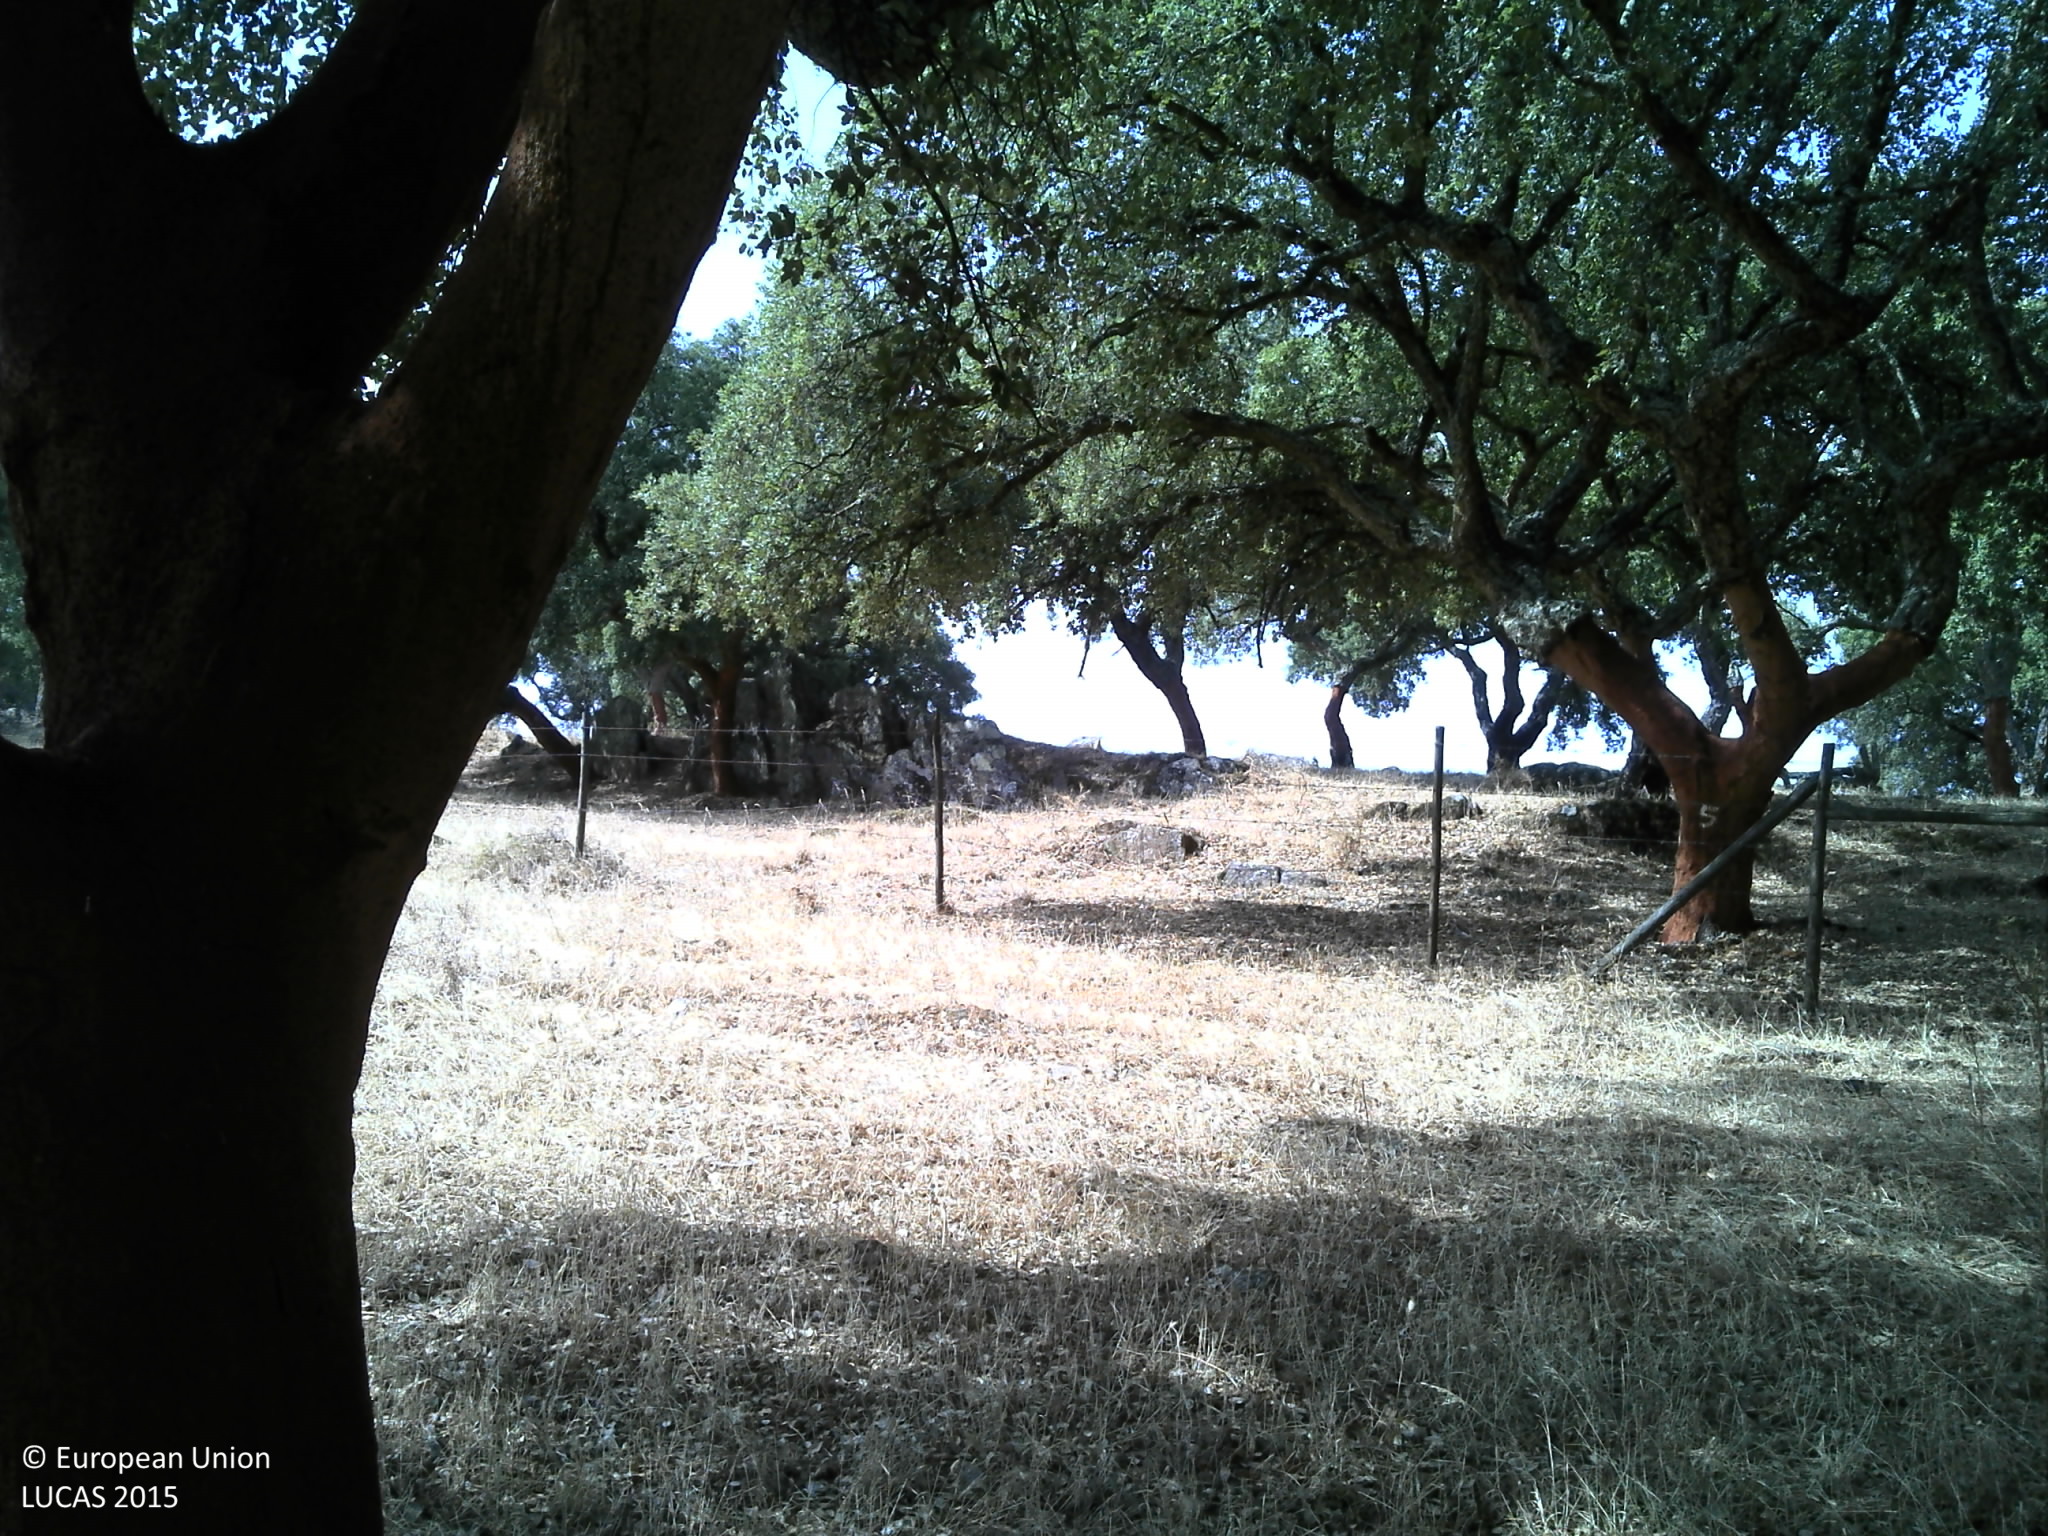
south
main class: Woodland
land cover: Broadleaved woodland
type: broadleaved evergreen forest
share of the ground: 50 - 75 %
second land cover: Grassland without tree/shrub cover
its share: 50 - 75 %
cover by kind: broadleaved forest trees 50 %, herbaceous plants 50 %
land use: Forestry
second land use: Agriculture (excluding fallow land and kitchen gardens)
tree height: > 5 m
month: July
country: PT
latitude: 38.7563
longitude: -7.4897
